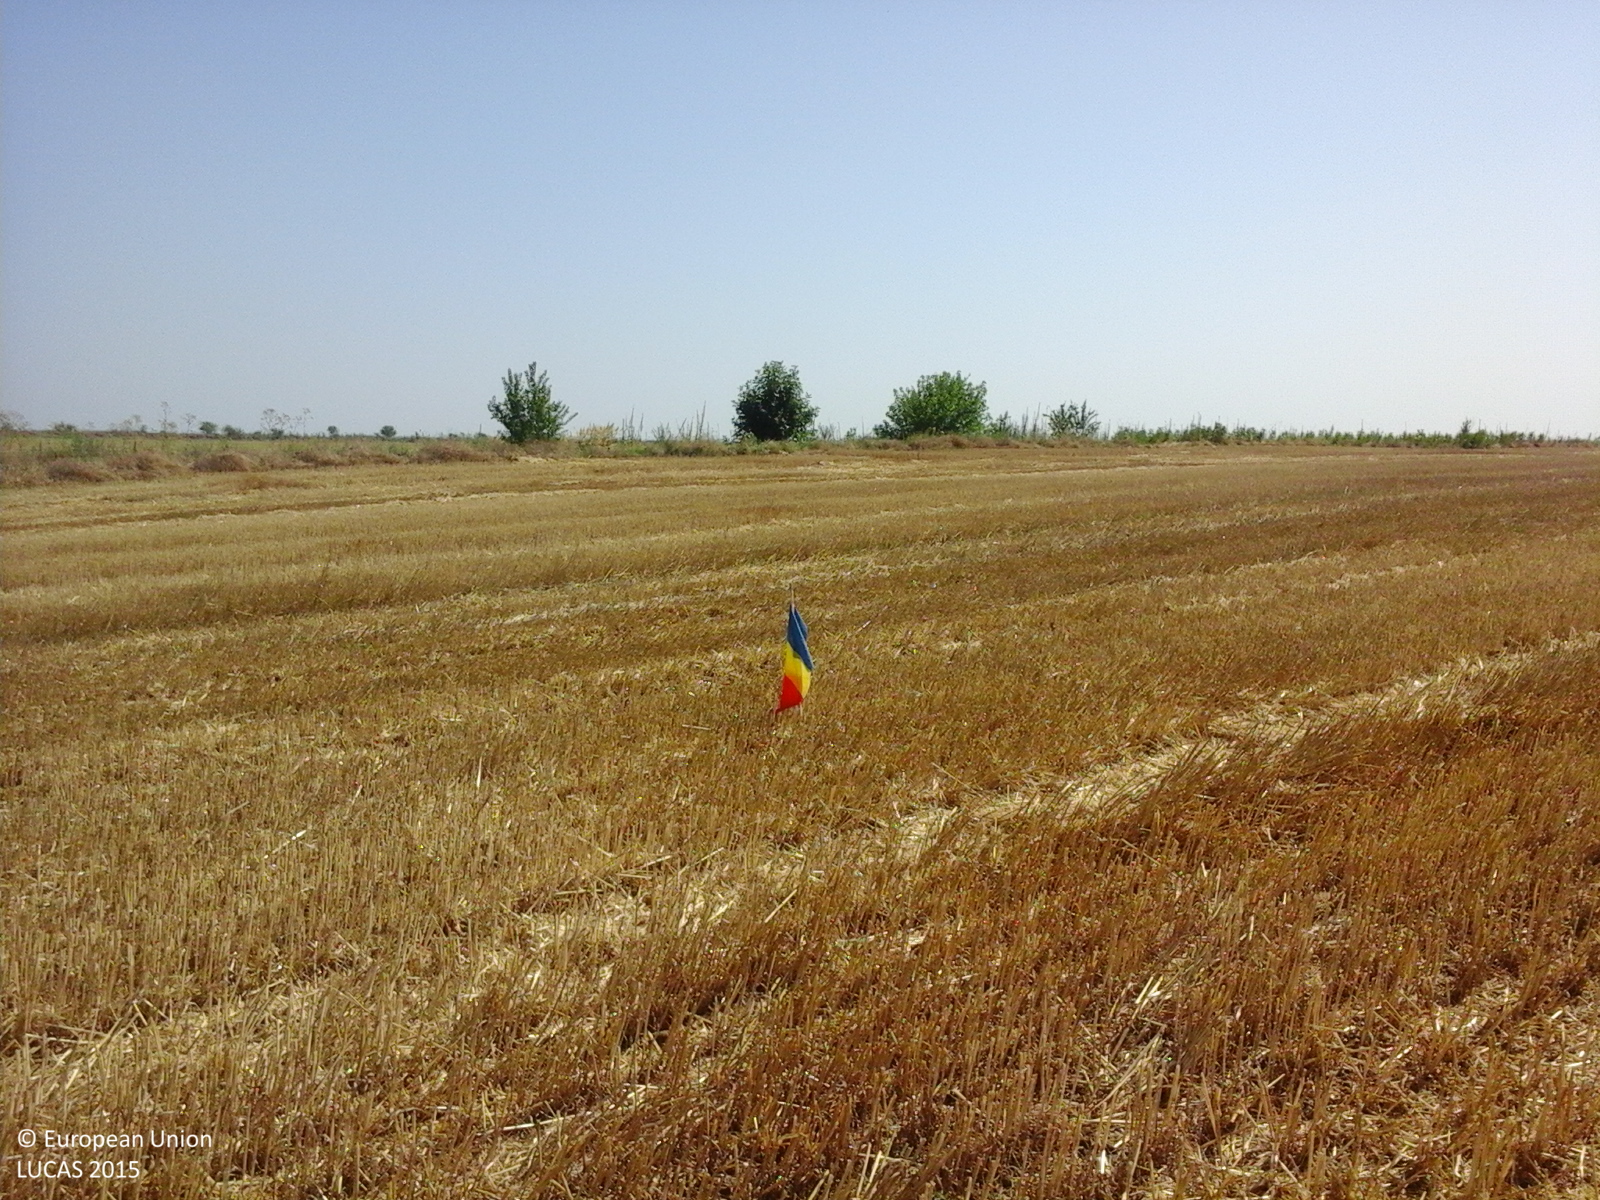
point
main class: Cropland
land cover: Durum wheat
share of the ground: > 75 %
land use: Agriculture (excluding fallow land and kitchen gardens)
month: July
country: RO
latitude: 44.2868
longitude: 27.4964
